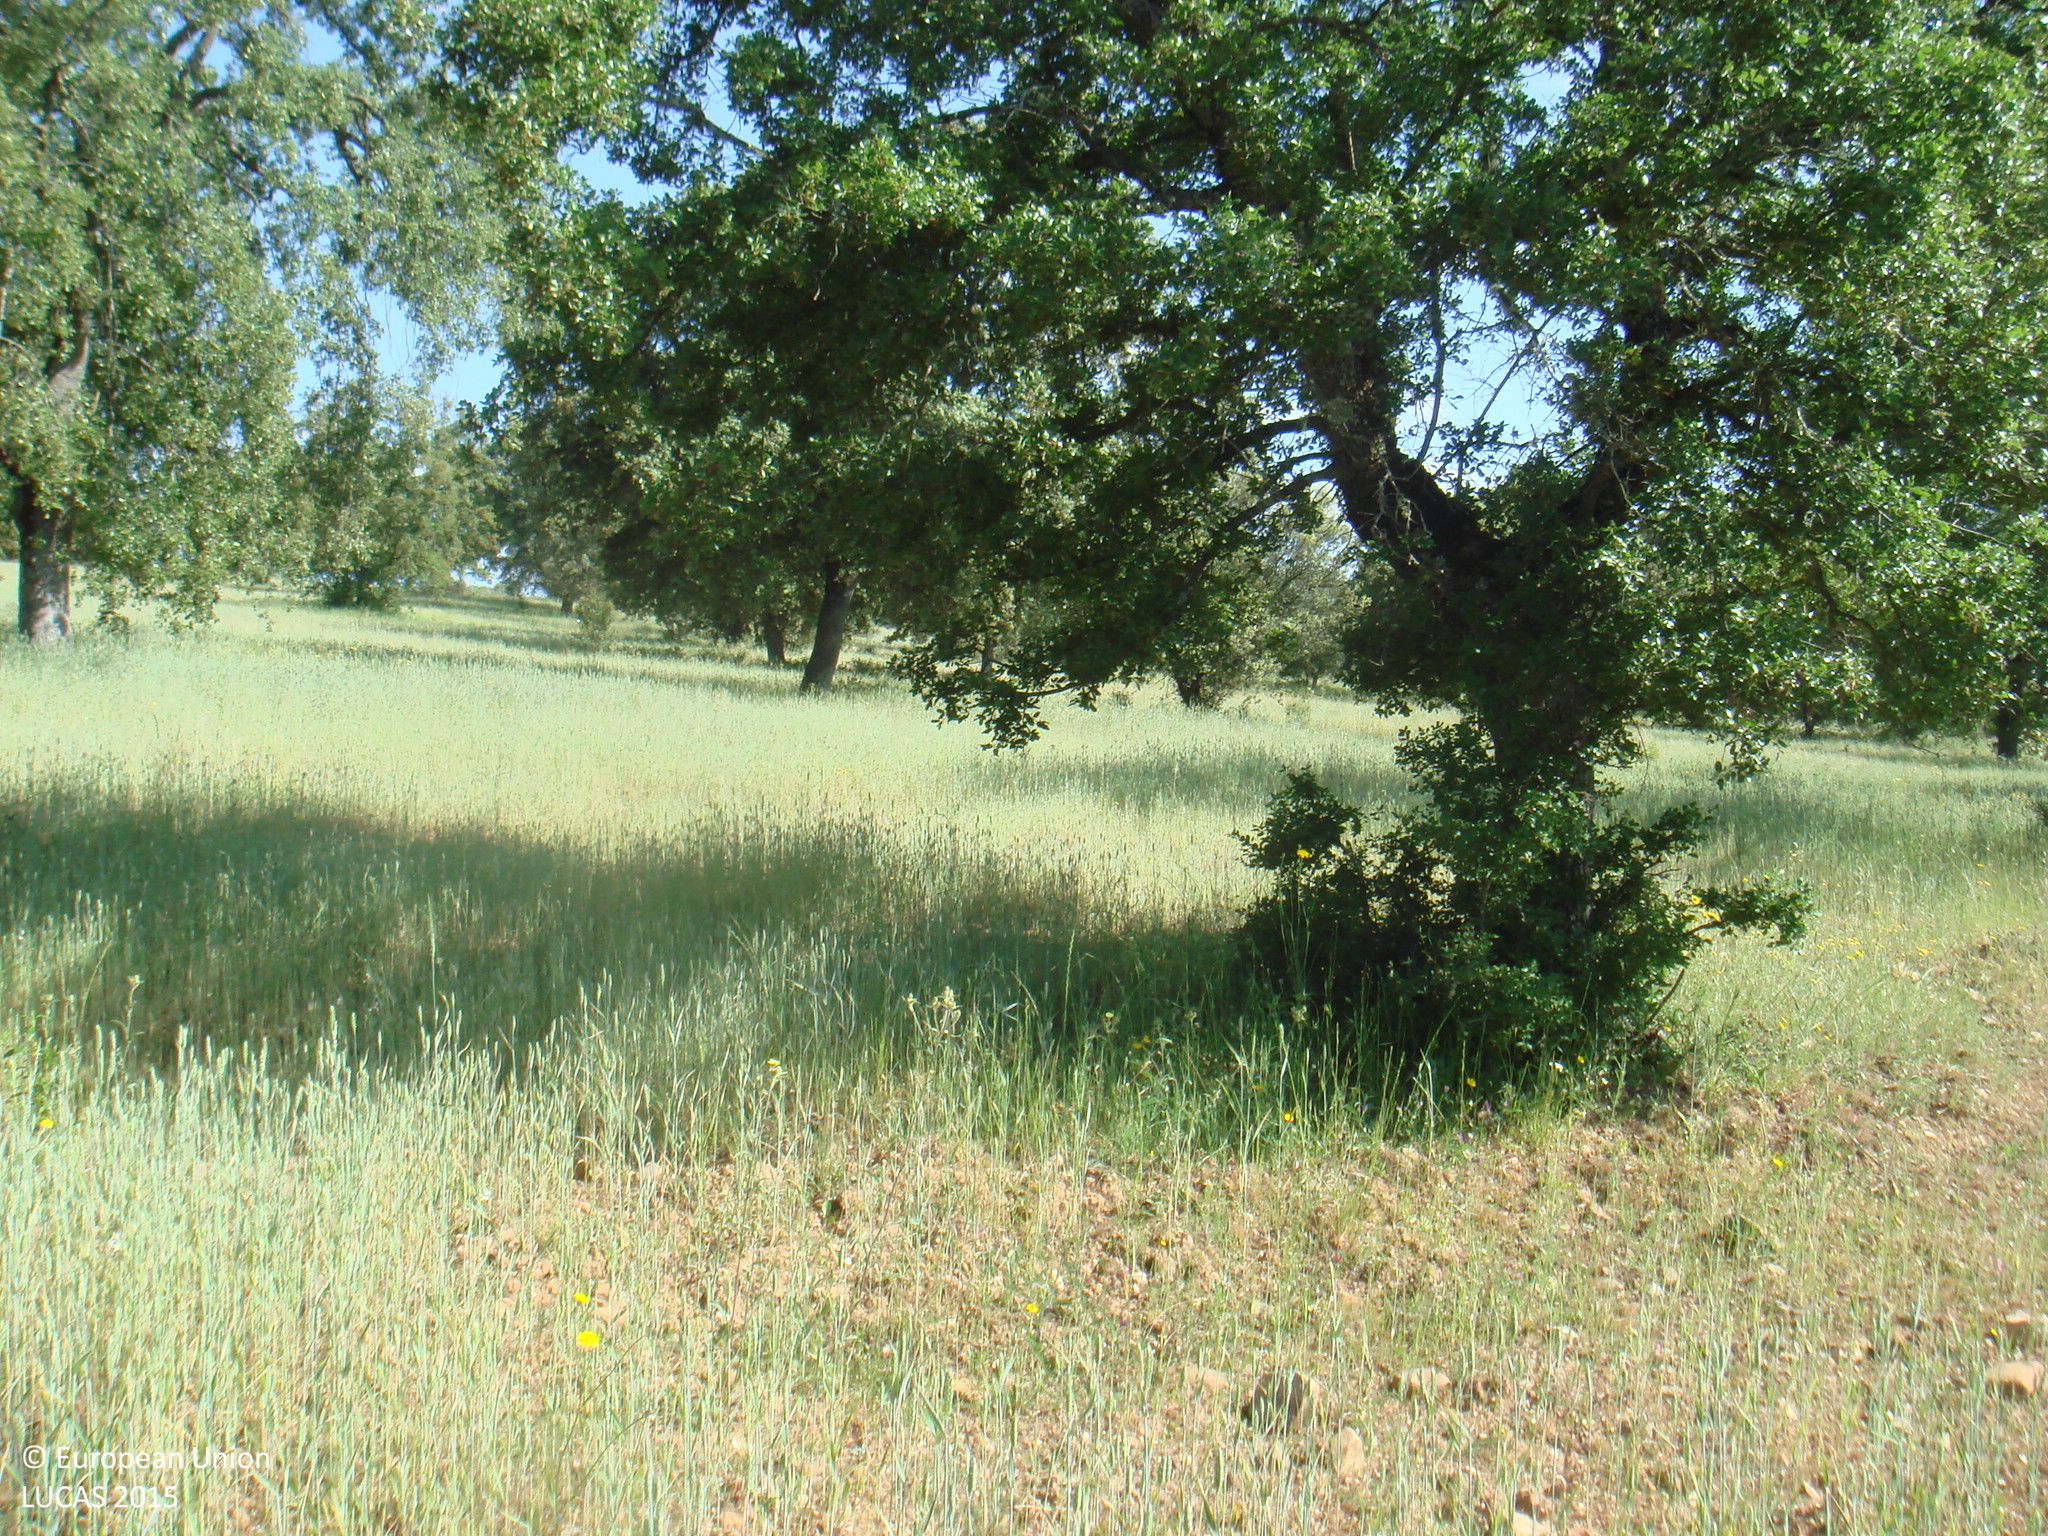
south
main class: Woodland
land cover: Broadleaved woodland
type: broadleaved evergreen forest
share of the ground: 50 - 75 %
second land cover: Common wheat
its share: > 75 %
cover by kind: herbaceous plants 60 %, broadleaved forest trees 40 %
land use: Forestry
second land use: Agriculture (excluding fallow land and kitchen gardens)
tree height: > 5 m
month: May
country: ES
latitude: 38.3966
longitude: -4.3640
